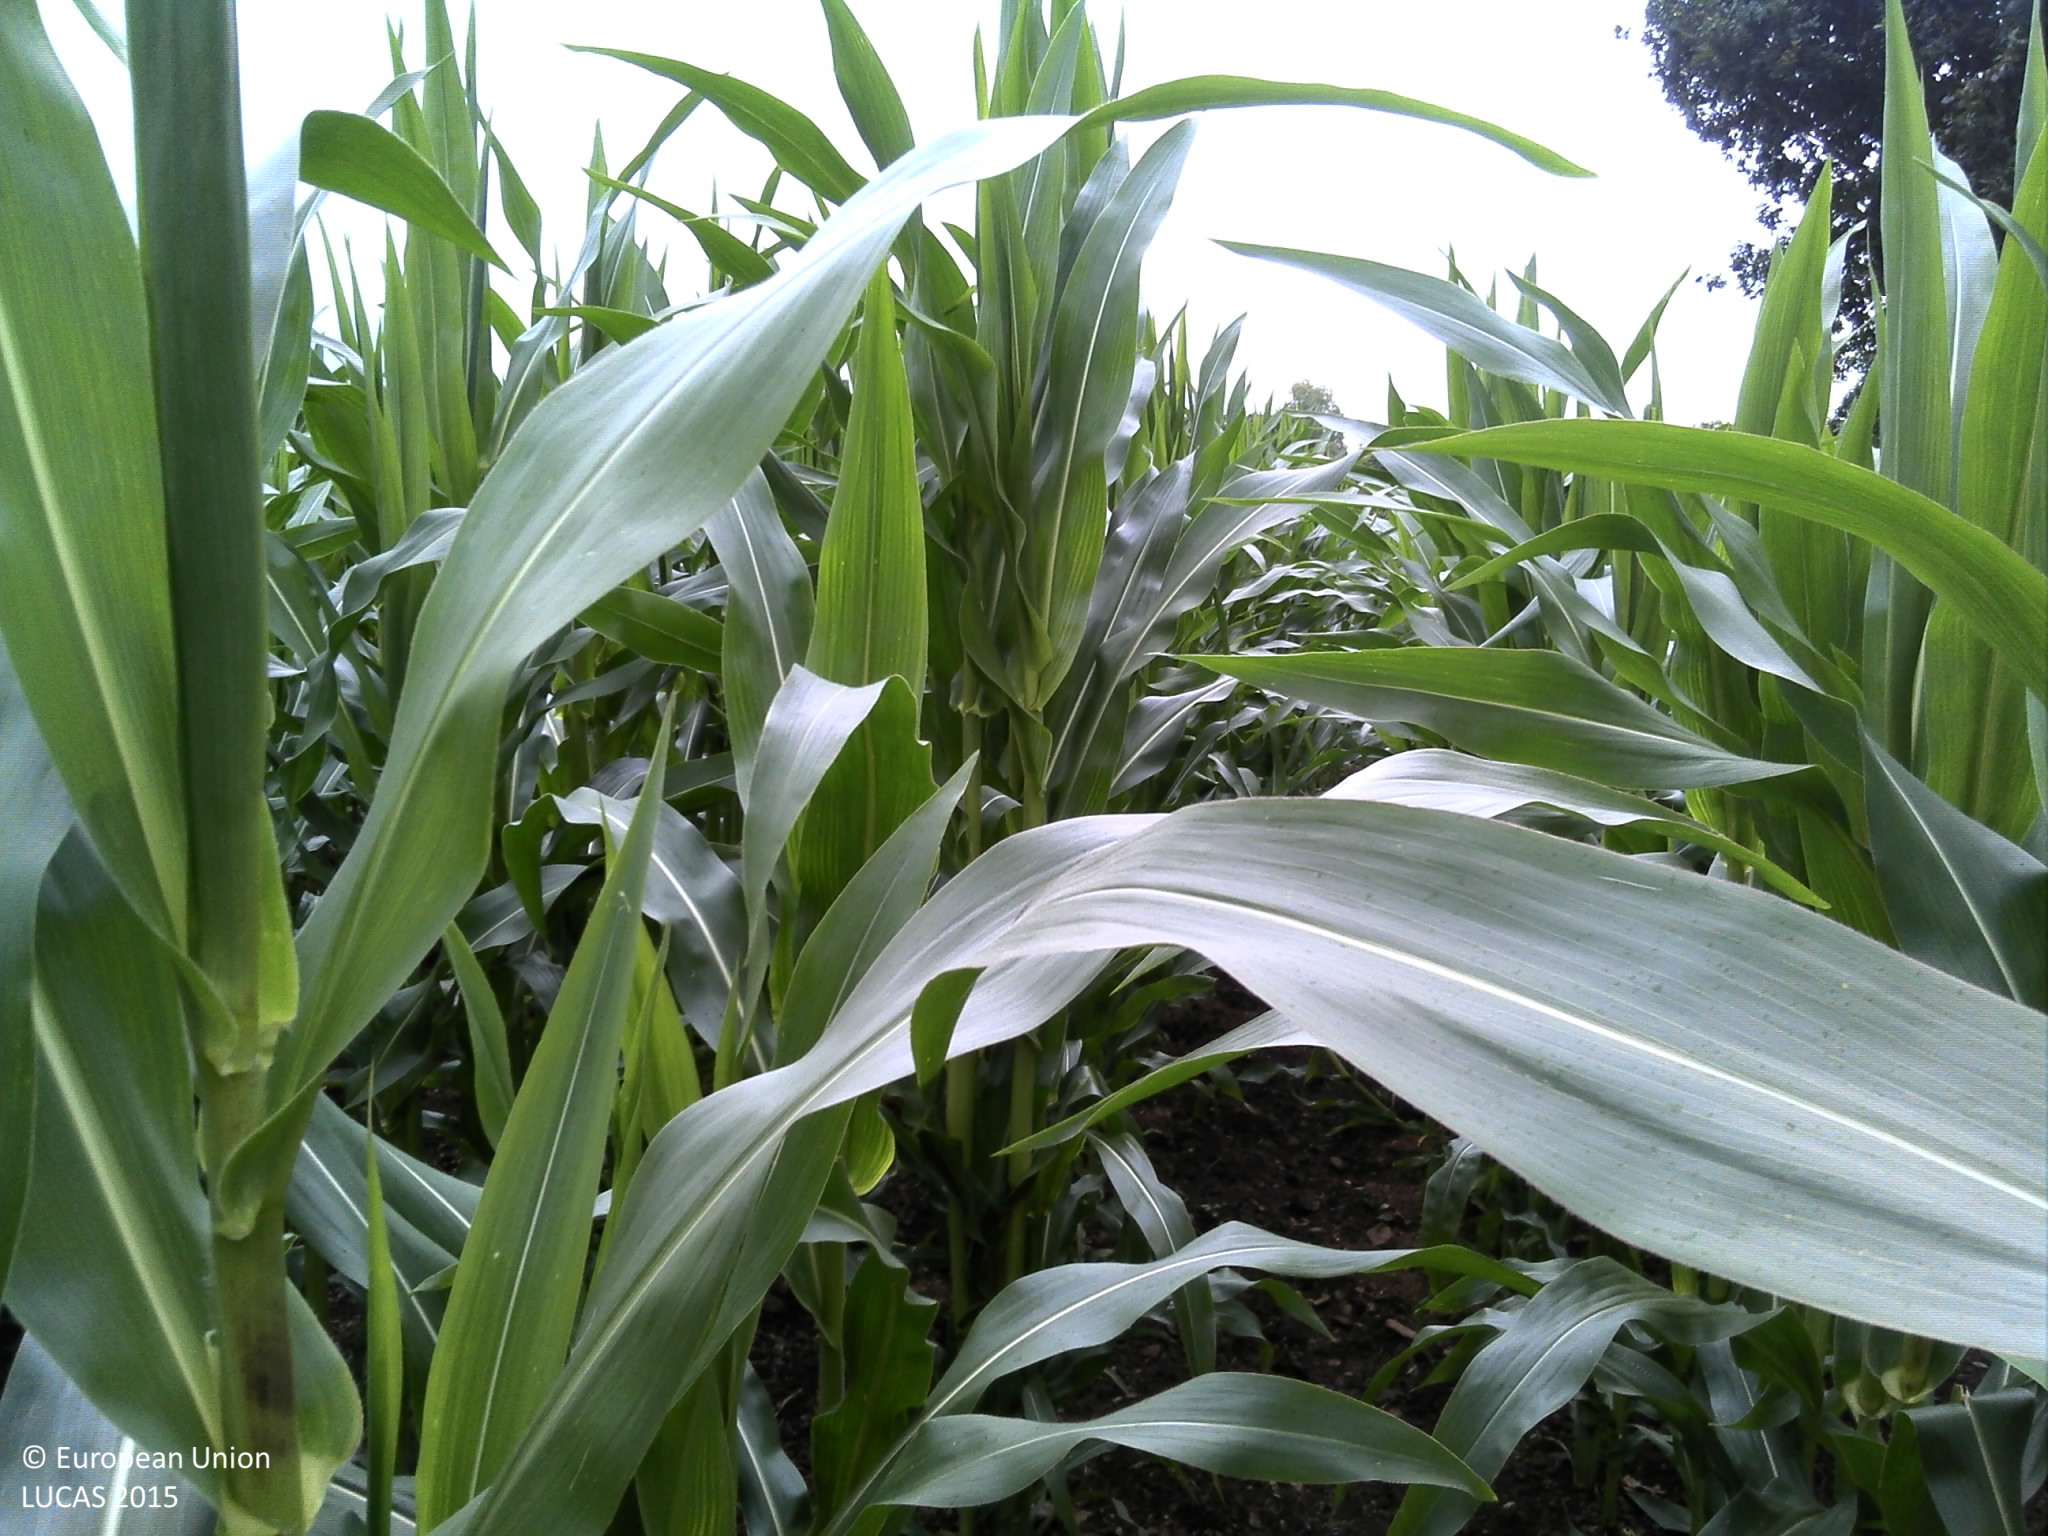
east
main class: Cropland
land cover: Maize
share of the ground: > 75 %
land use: Agriculture (excluding fallow land and kitchen gardens)
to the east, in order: Maize; Fences; Grassland without tree/shrub cover; Fences; Tracks; Grassland without tree/shrub cover; Fences; Broadleaved woodland; Temporary grasslands
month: July
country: FR
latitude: 48.3233
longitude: -4.1855
